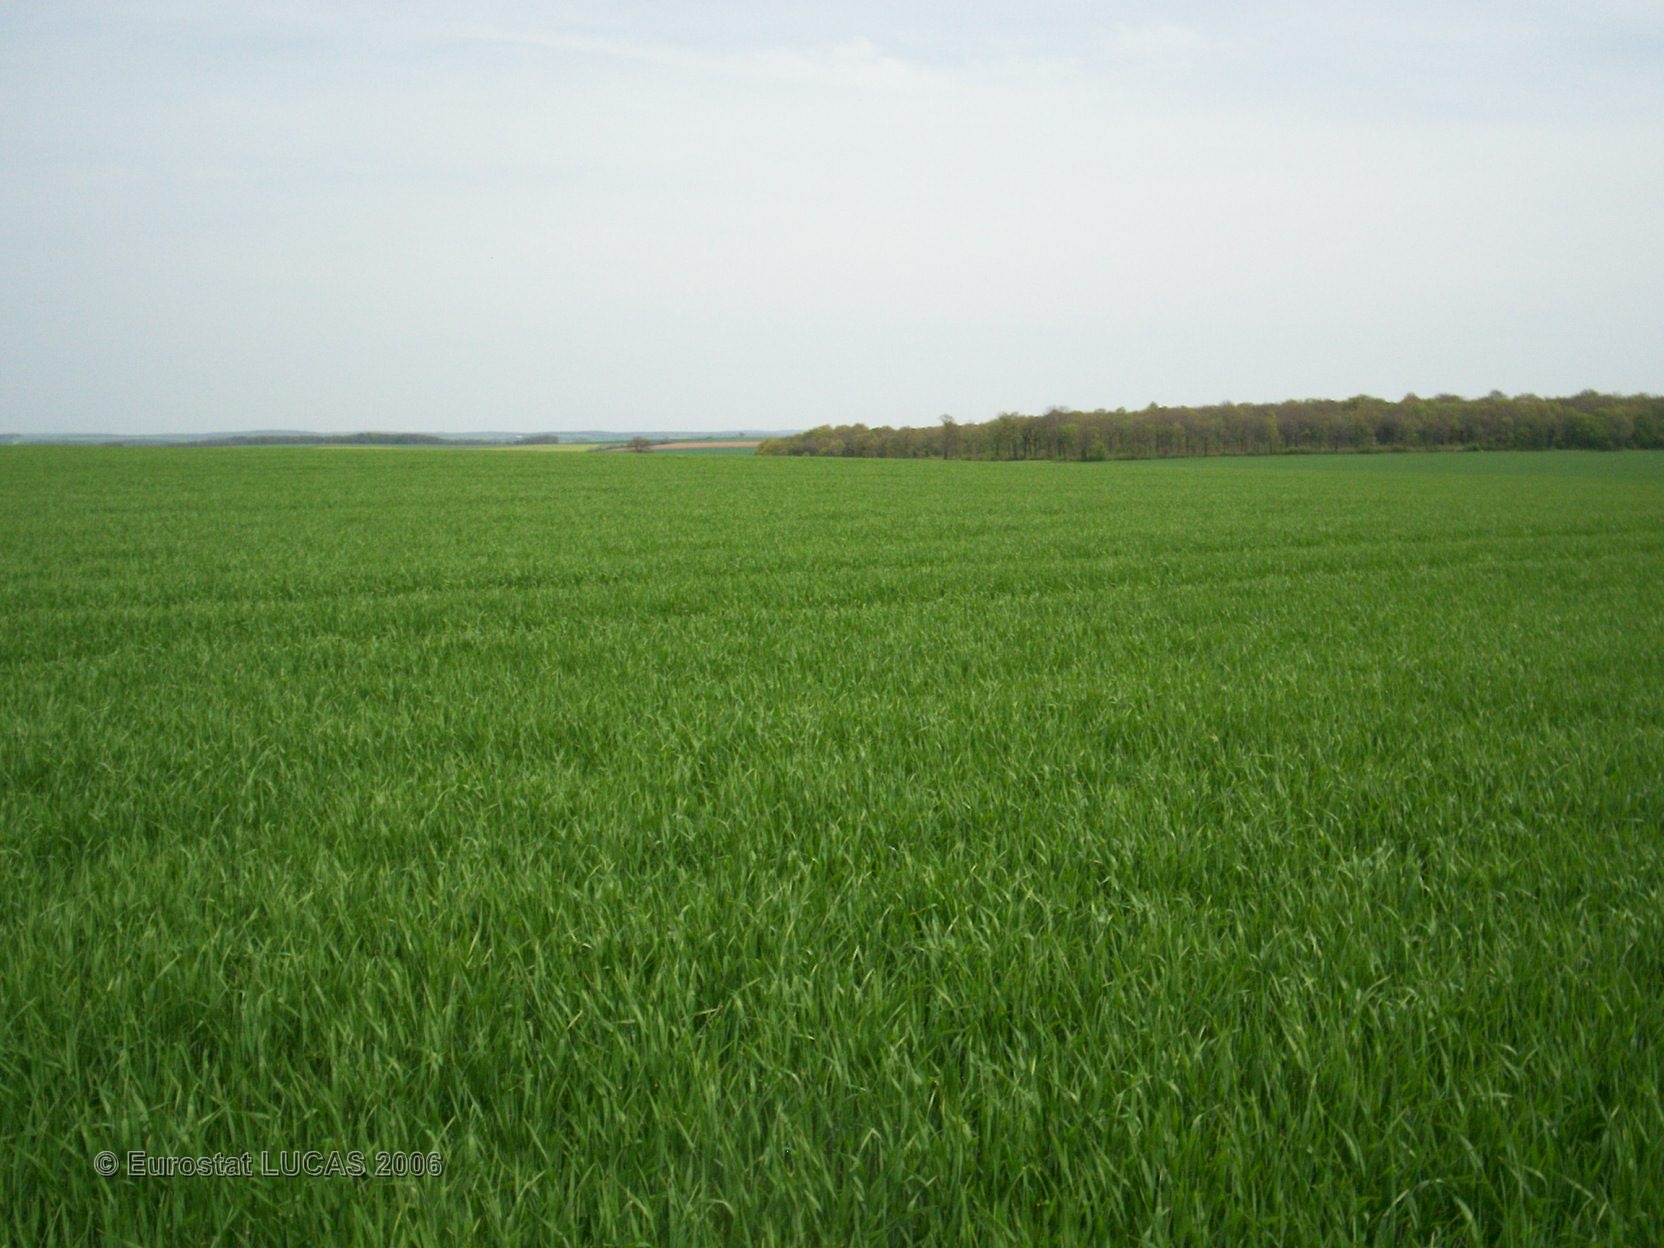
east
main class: Cropland
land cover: Barley
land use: Agriculture (excluding fallow land and kitchen gardens)
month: May
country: FR
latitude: 47.6420
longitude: 4.6347
